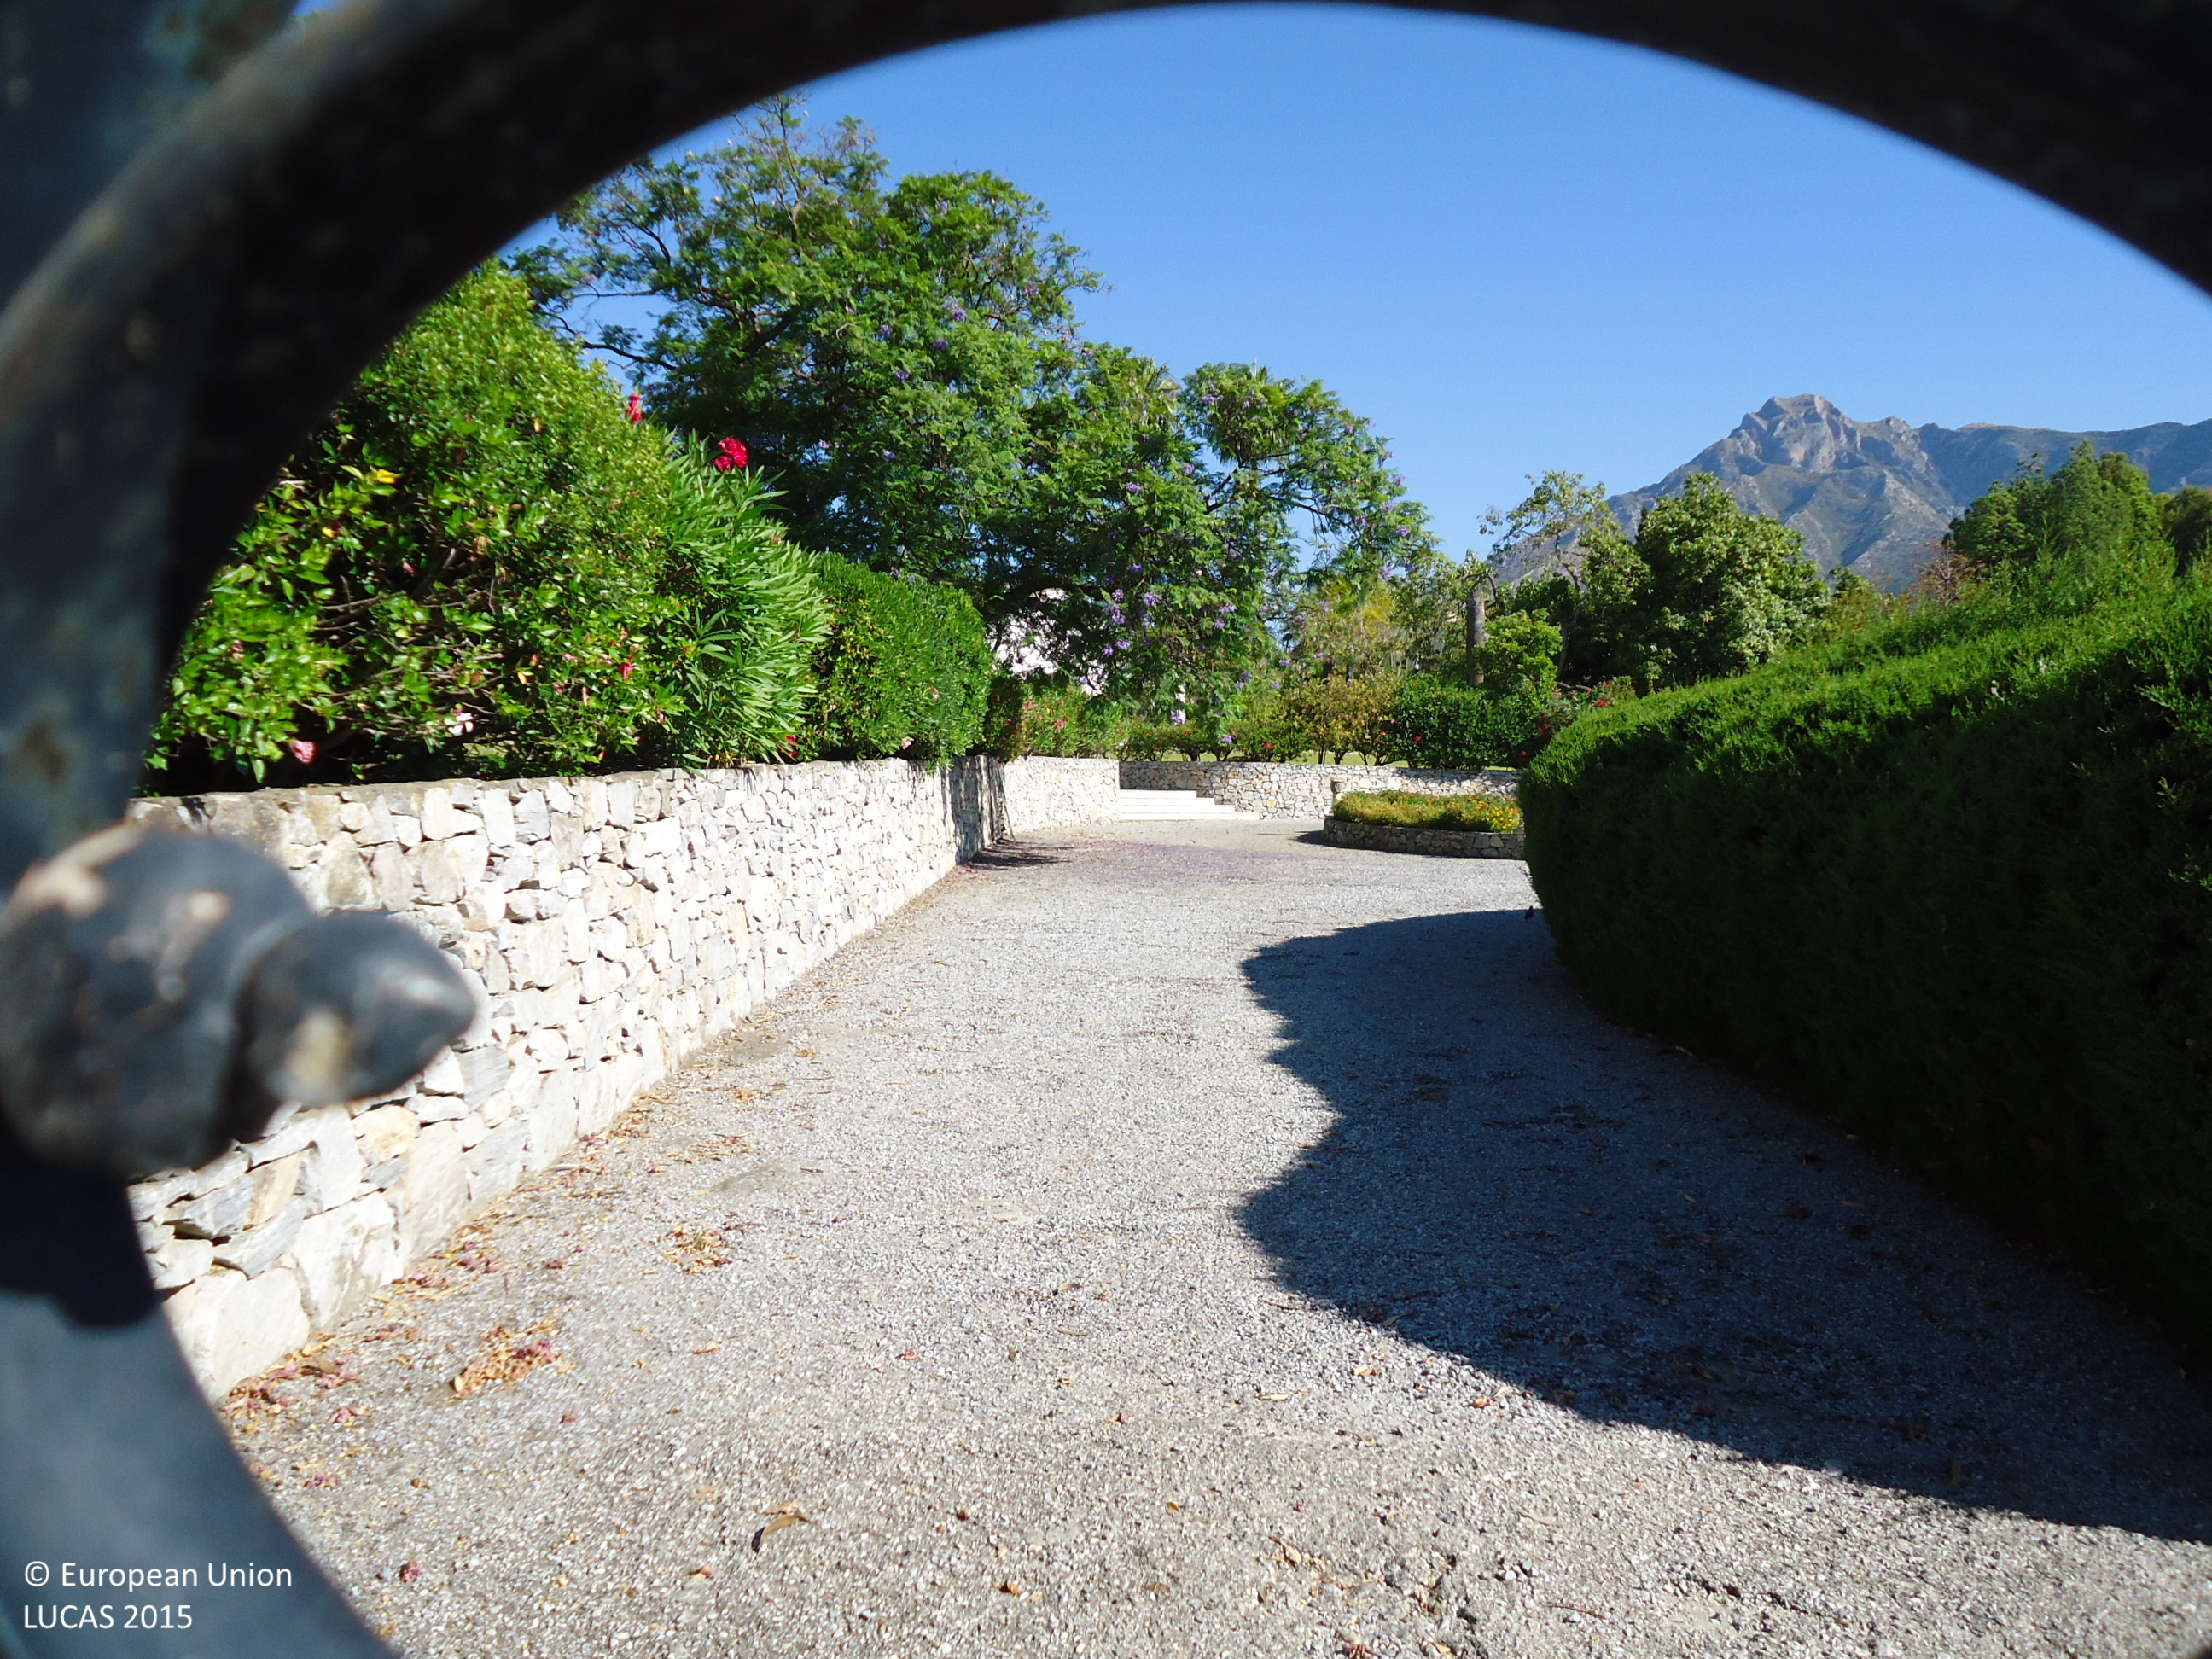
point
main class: Woodland
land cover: Broadleaved woodland
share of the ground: 25 - 50 %
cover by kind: herbaceous plants 70 %, broadleaved forest trees 30 %
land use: Residential
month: June
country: ES
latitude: 36.5081
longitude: -4.9200
